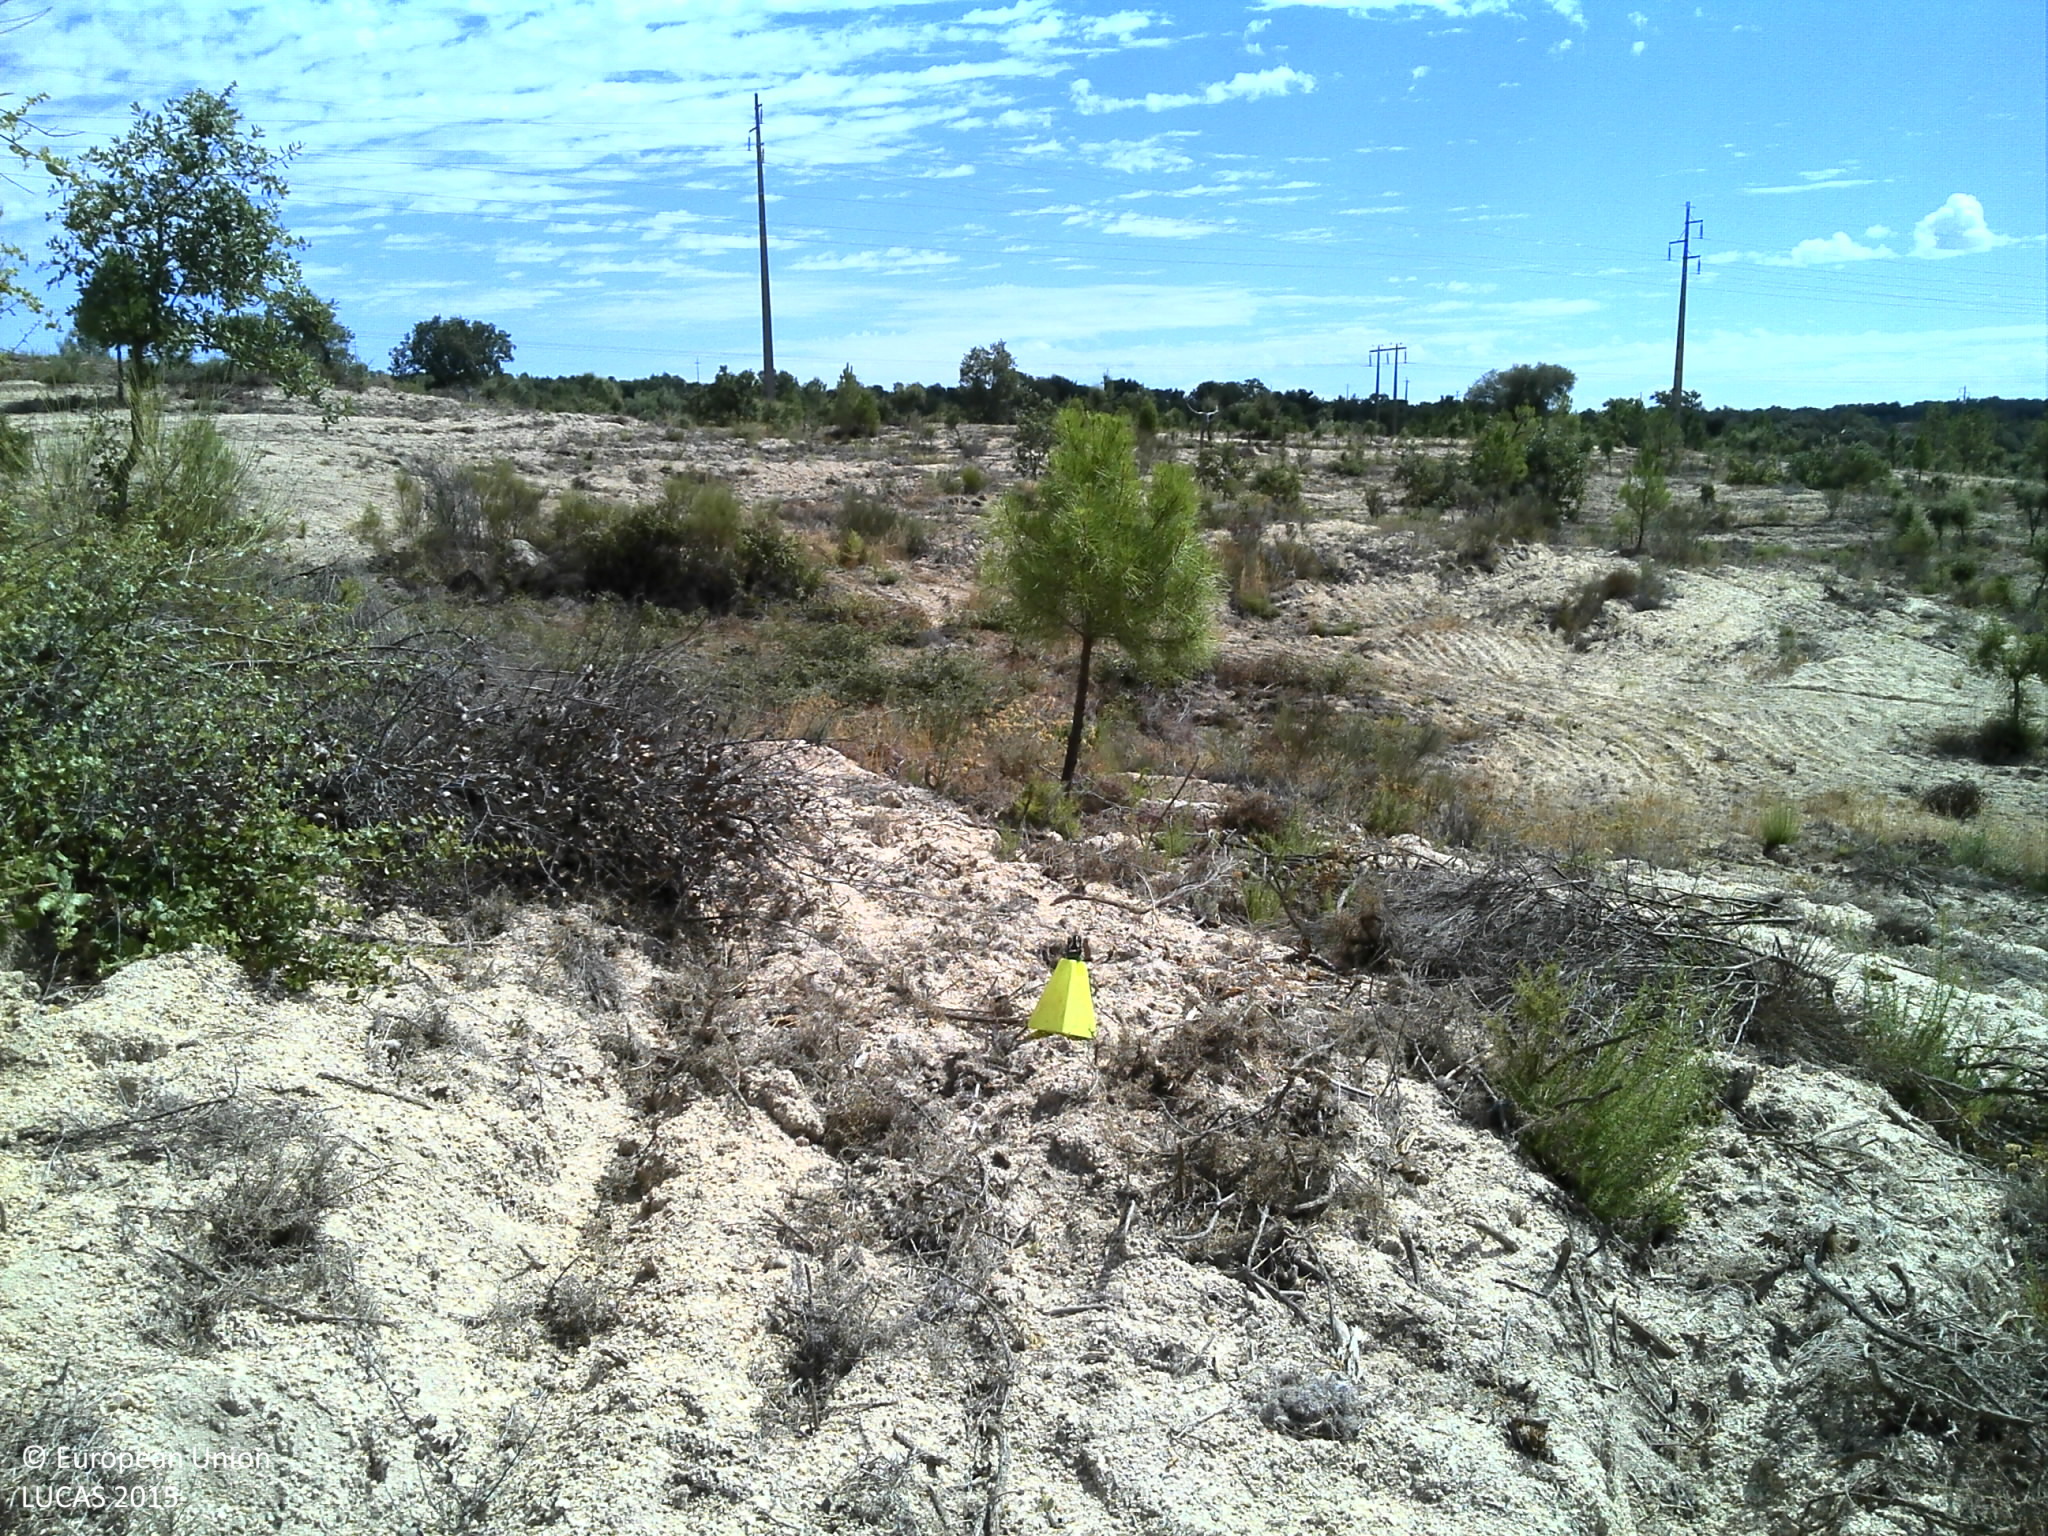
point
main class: Woodland
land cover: Broadleaved woodland
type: broadleaved evergreen forest
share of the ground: 10 - 25 %
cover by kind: unconsolidated bare surface 90 %, broadleaved forest trees 10 %
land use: Forestry
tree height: < 5 m
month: August
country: PT
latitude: 39.4905
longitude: -7.7138
